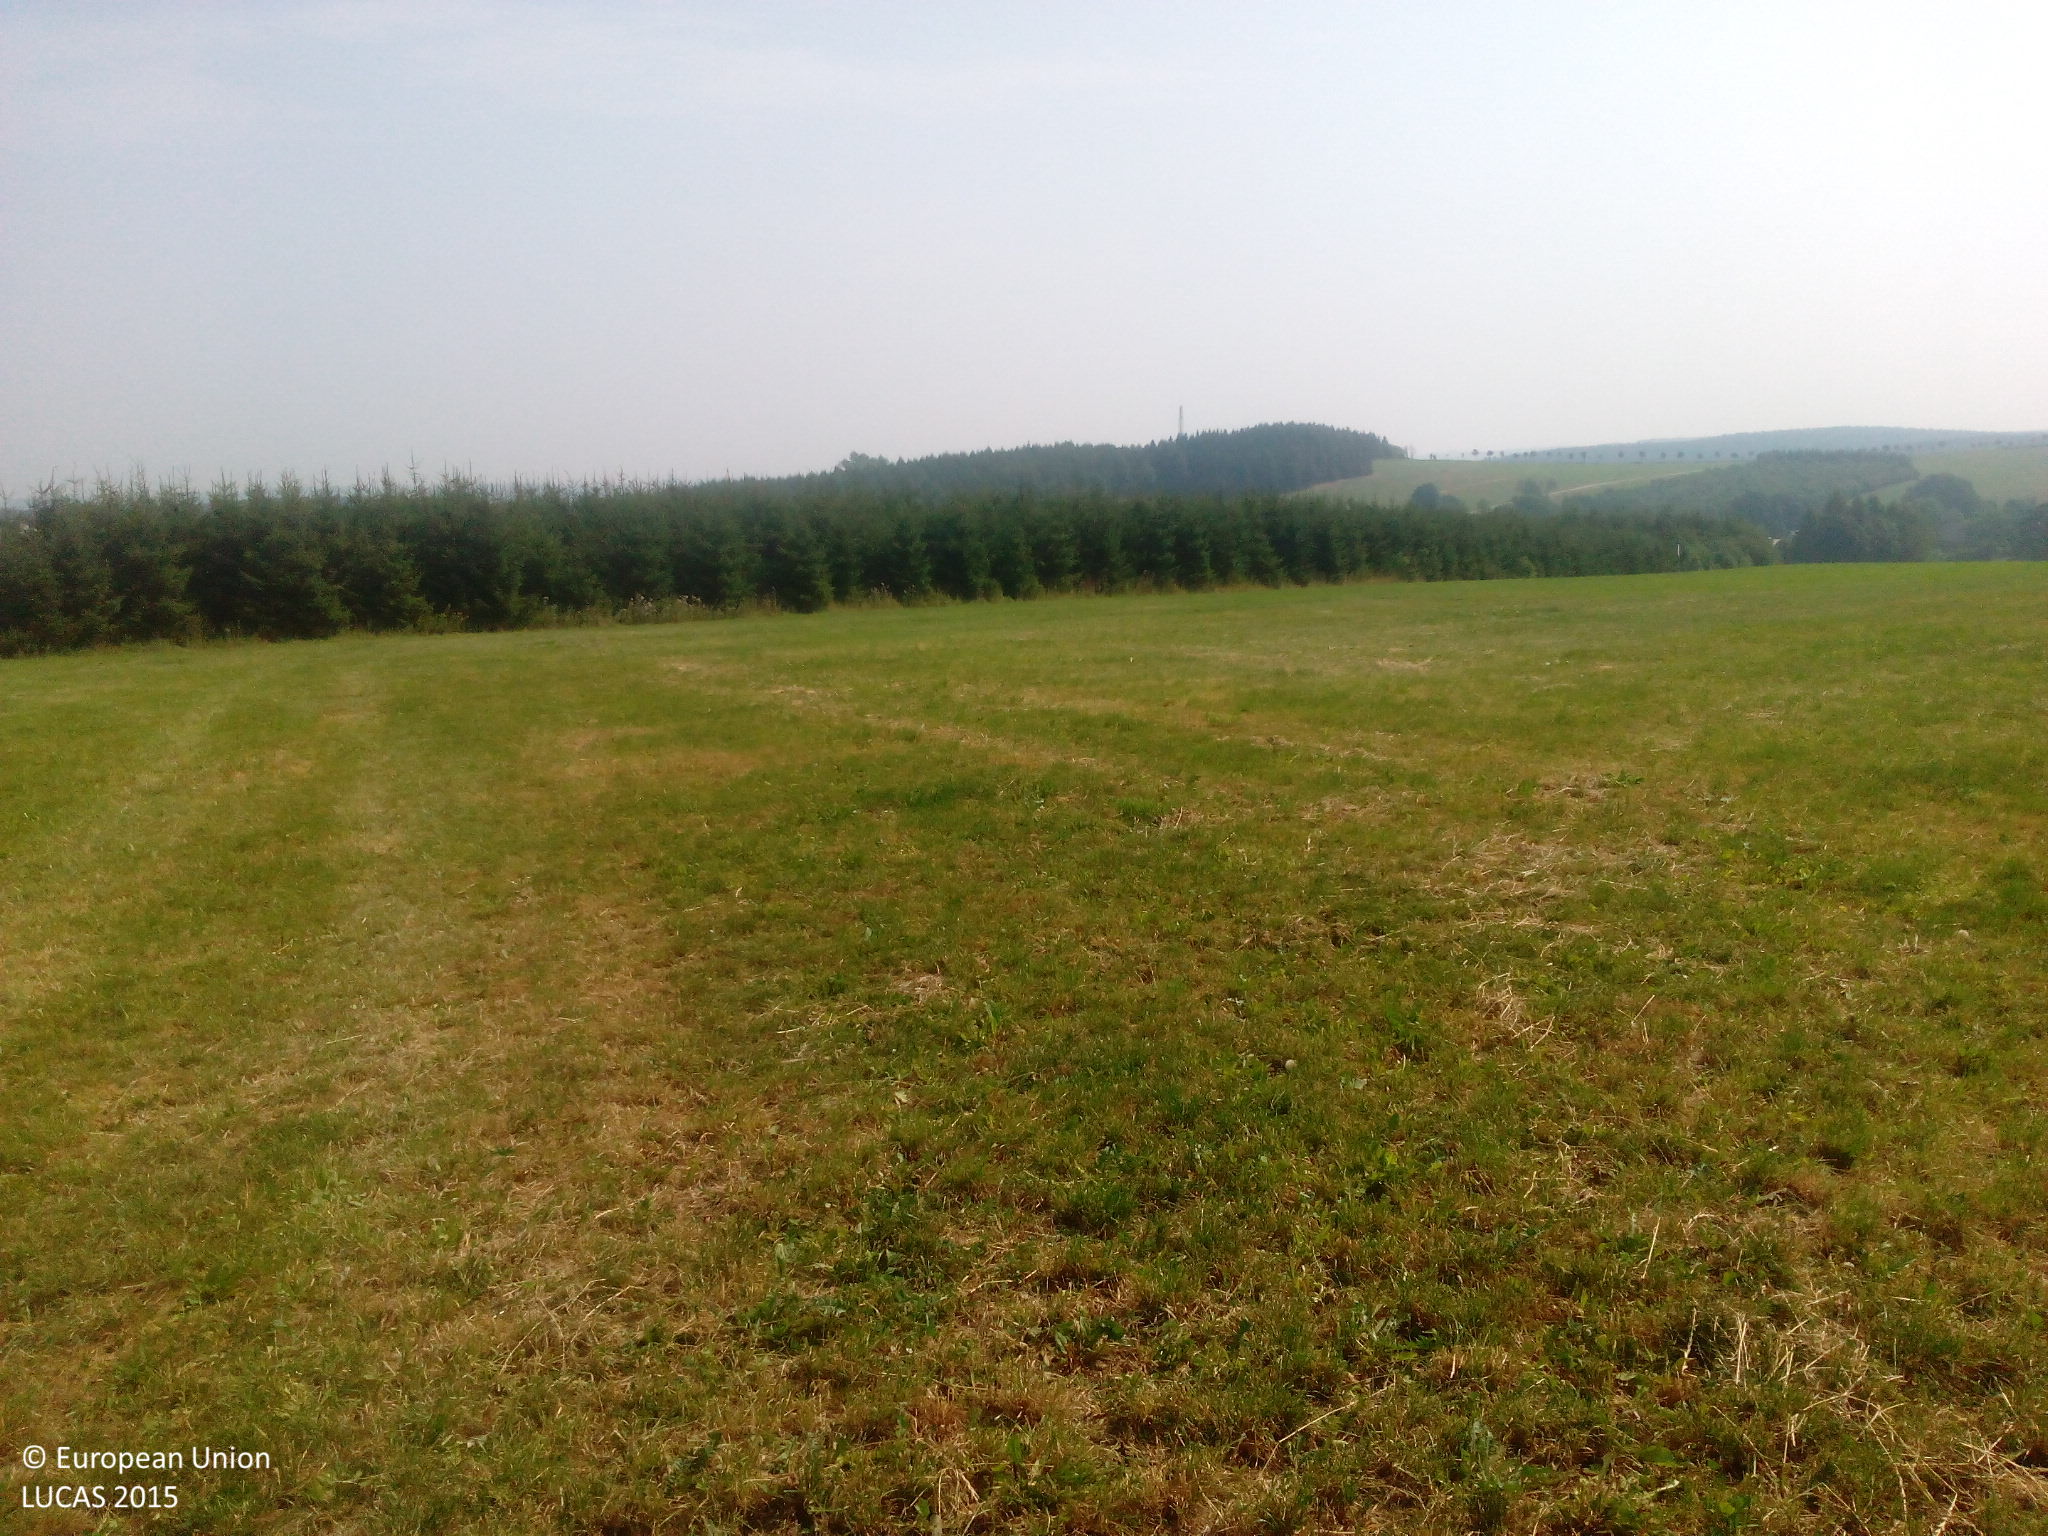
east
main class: Grassland
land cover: Grassland without tree/shrub cover
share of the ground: > 75 %
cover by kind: herbaceous plants 100 %
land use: Agriculture (excluding fallow land and kitchen gardens)
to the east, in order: Grassland without tree/shrub cover; Fences; Spruce dominated coniferous woodland; Broadleaved woodland; Fences; Grassland without tree/shrub cover
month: August
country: DE
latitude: 50.7458
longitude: 13.3875
